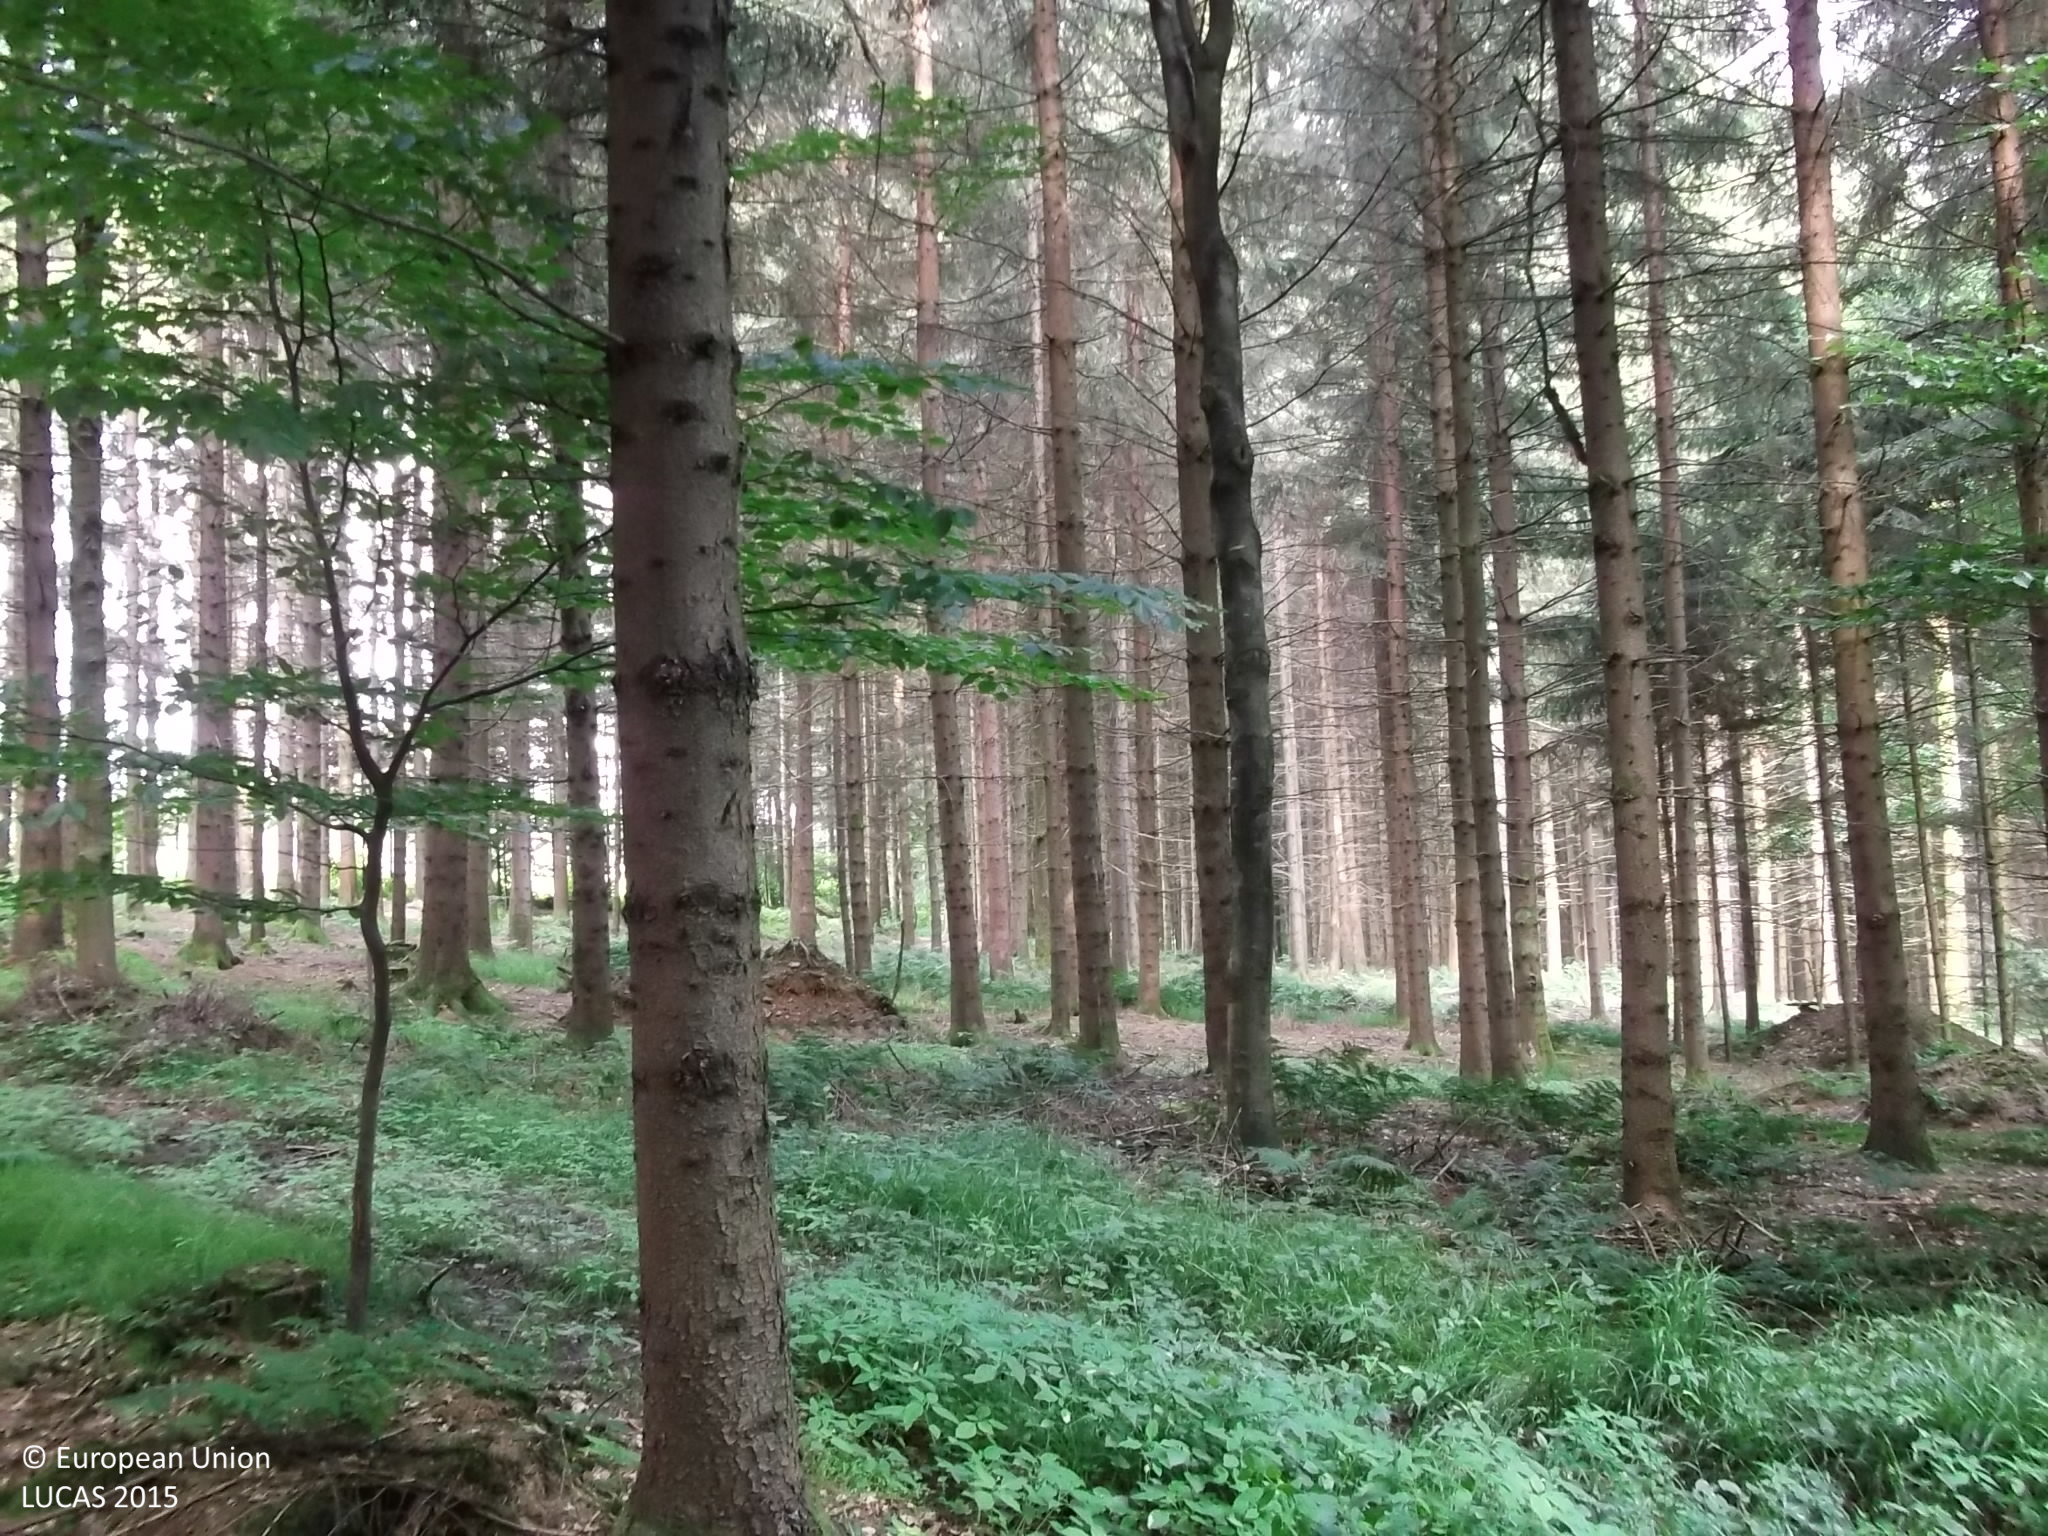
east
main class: Woodland
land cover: Spruce dominated mixed woodland
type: hemiboreal forest and nemoral coniferous forest and mixed broadleaved-coniferous forest
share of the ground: > 75 %
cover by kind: coniferous forest trees 65 %, broadleaved forest trees 30 %, herbaceous plants 5 %
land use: Forestry
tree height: > 5 m
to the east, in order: Spruce dominated mixed woodland; Tracks; Spruce dominated mixed woodland; Tracks; Spruce dominated mixed woodland; Tracks; Spruce dominated mixed woodland; Paved roads, cycling and walking lanes; Spruce dominated coniferous woodland; Grassland without tree/shrub cover
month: June
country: AT
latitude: 47.9914
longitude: 13.3893
